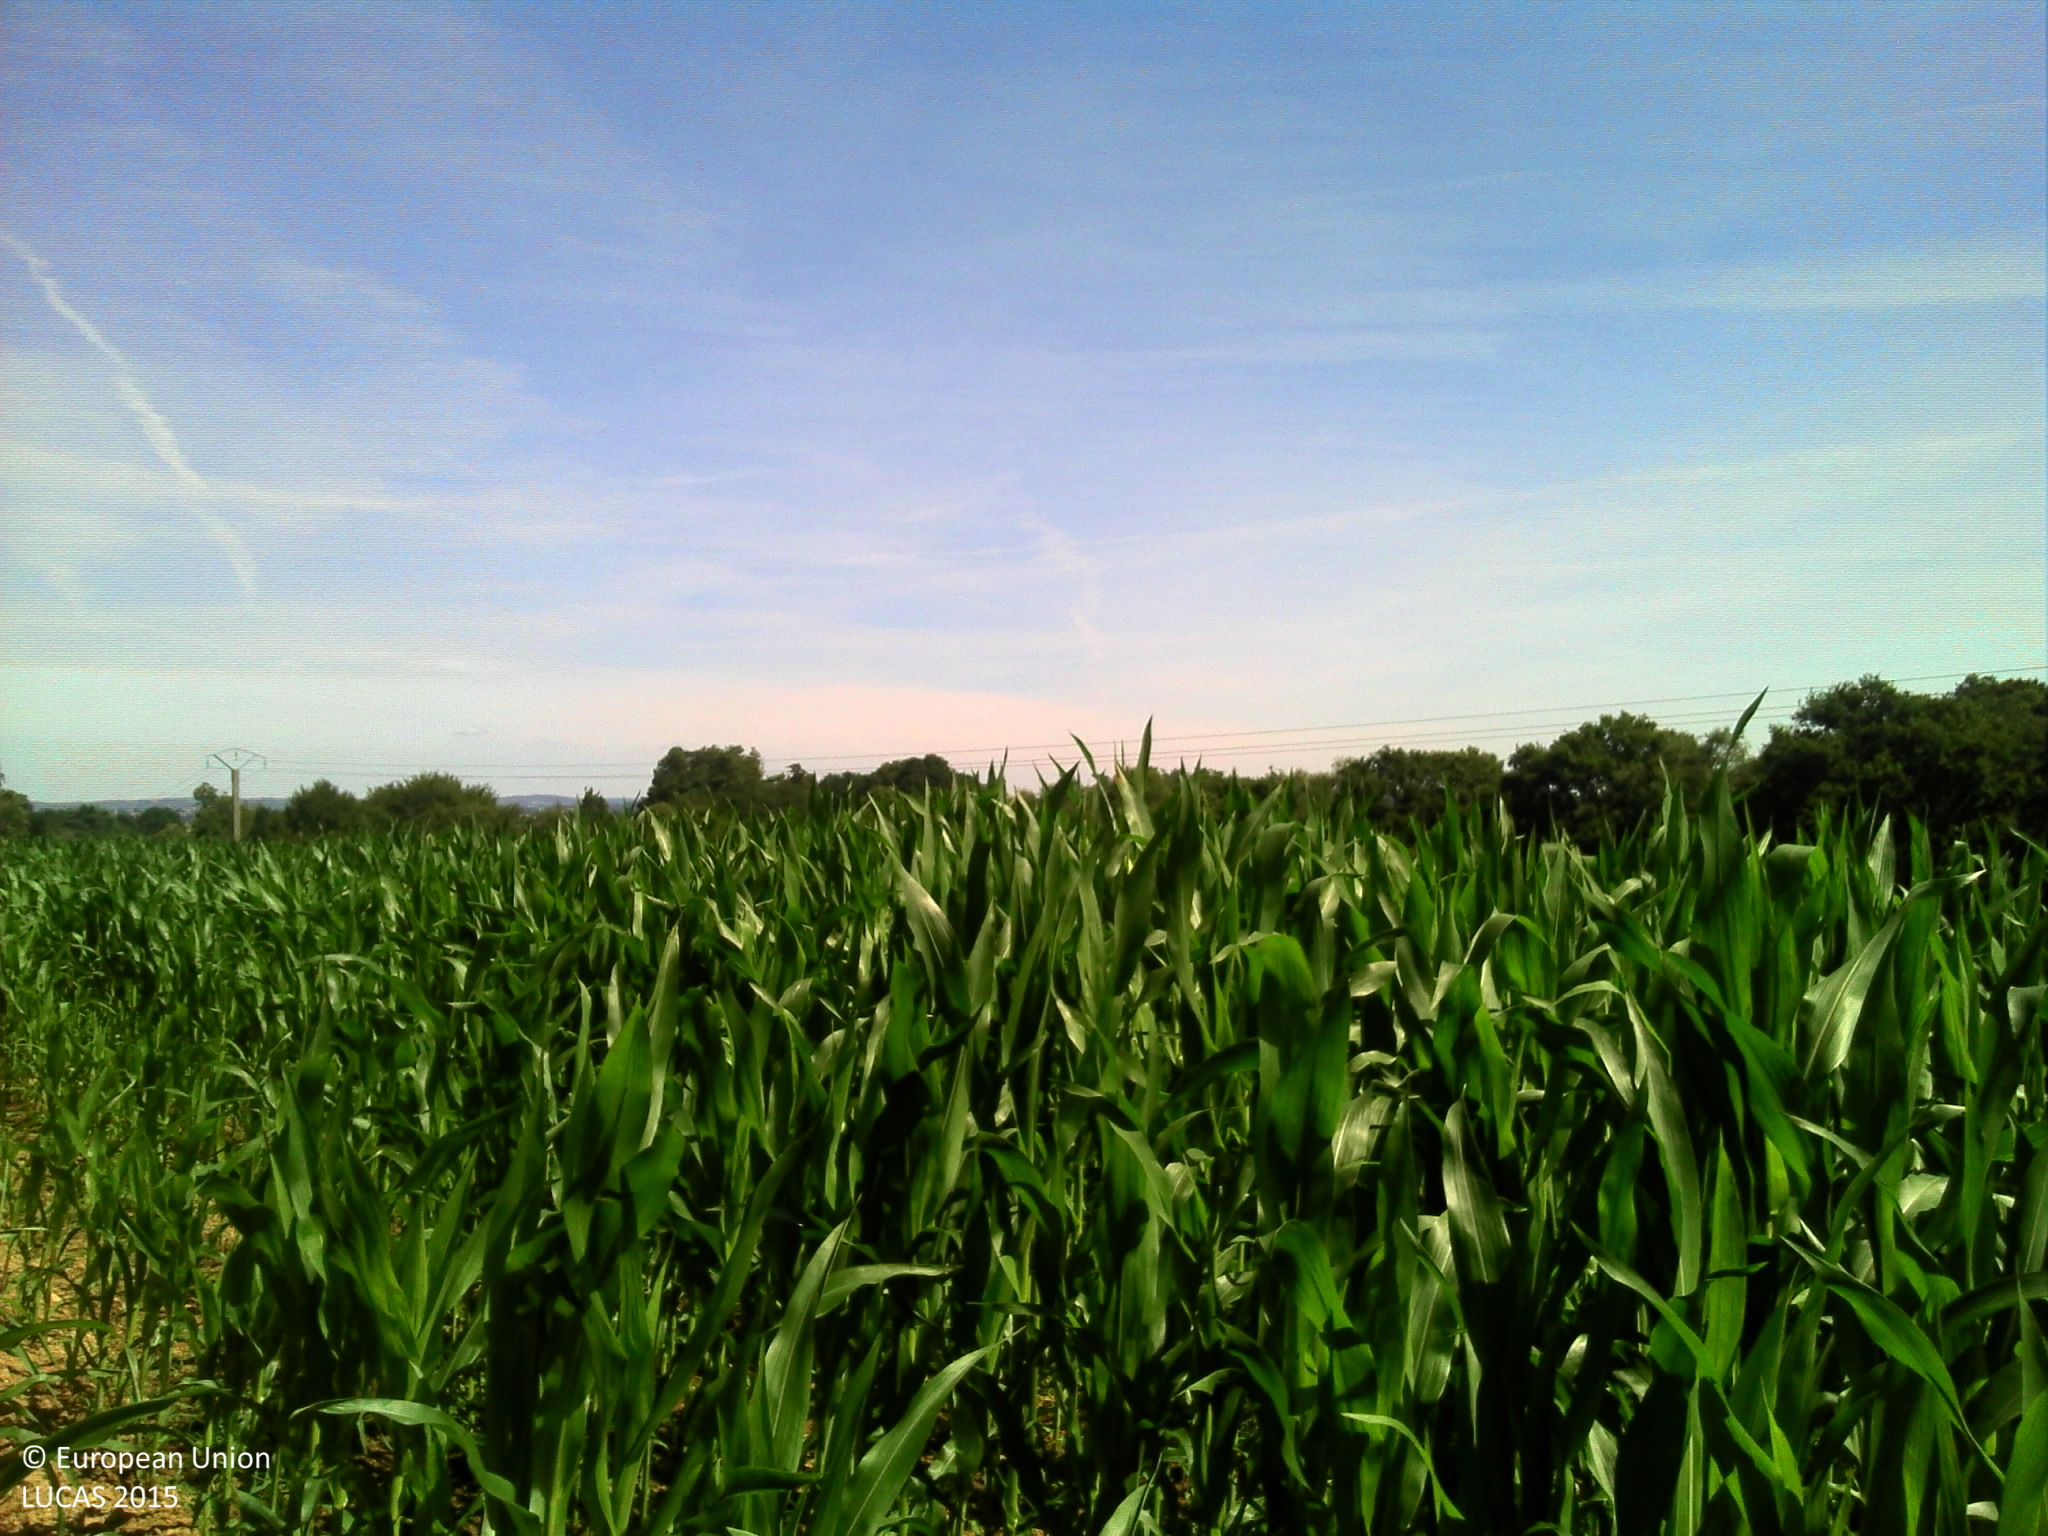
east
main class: Cropland
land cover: Maize
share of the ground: > 75 %
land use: Agriculture (excluding fallow land and kitchen gardens)
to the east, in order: Maize; Ditches and canals; Broadleaved woodland; Rivers and streams; Broadleaved woodland; Arable land (only in case pi)
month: July
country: FR
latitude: 48.0703
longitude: -2.9922
